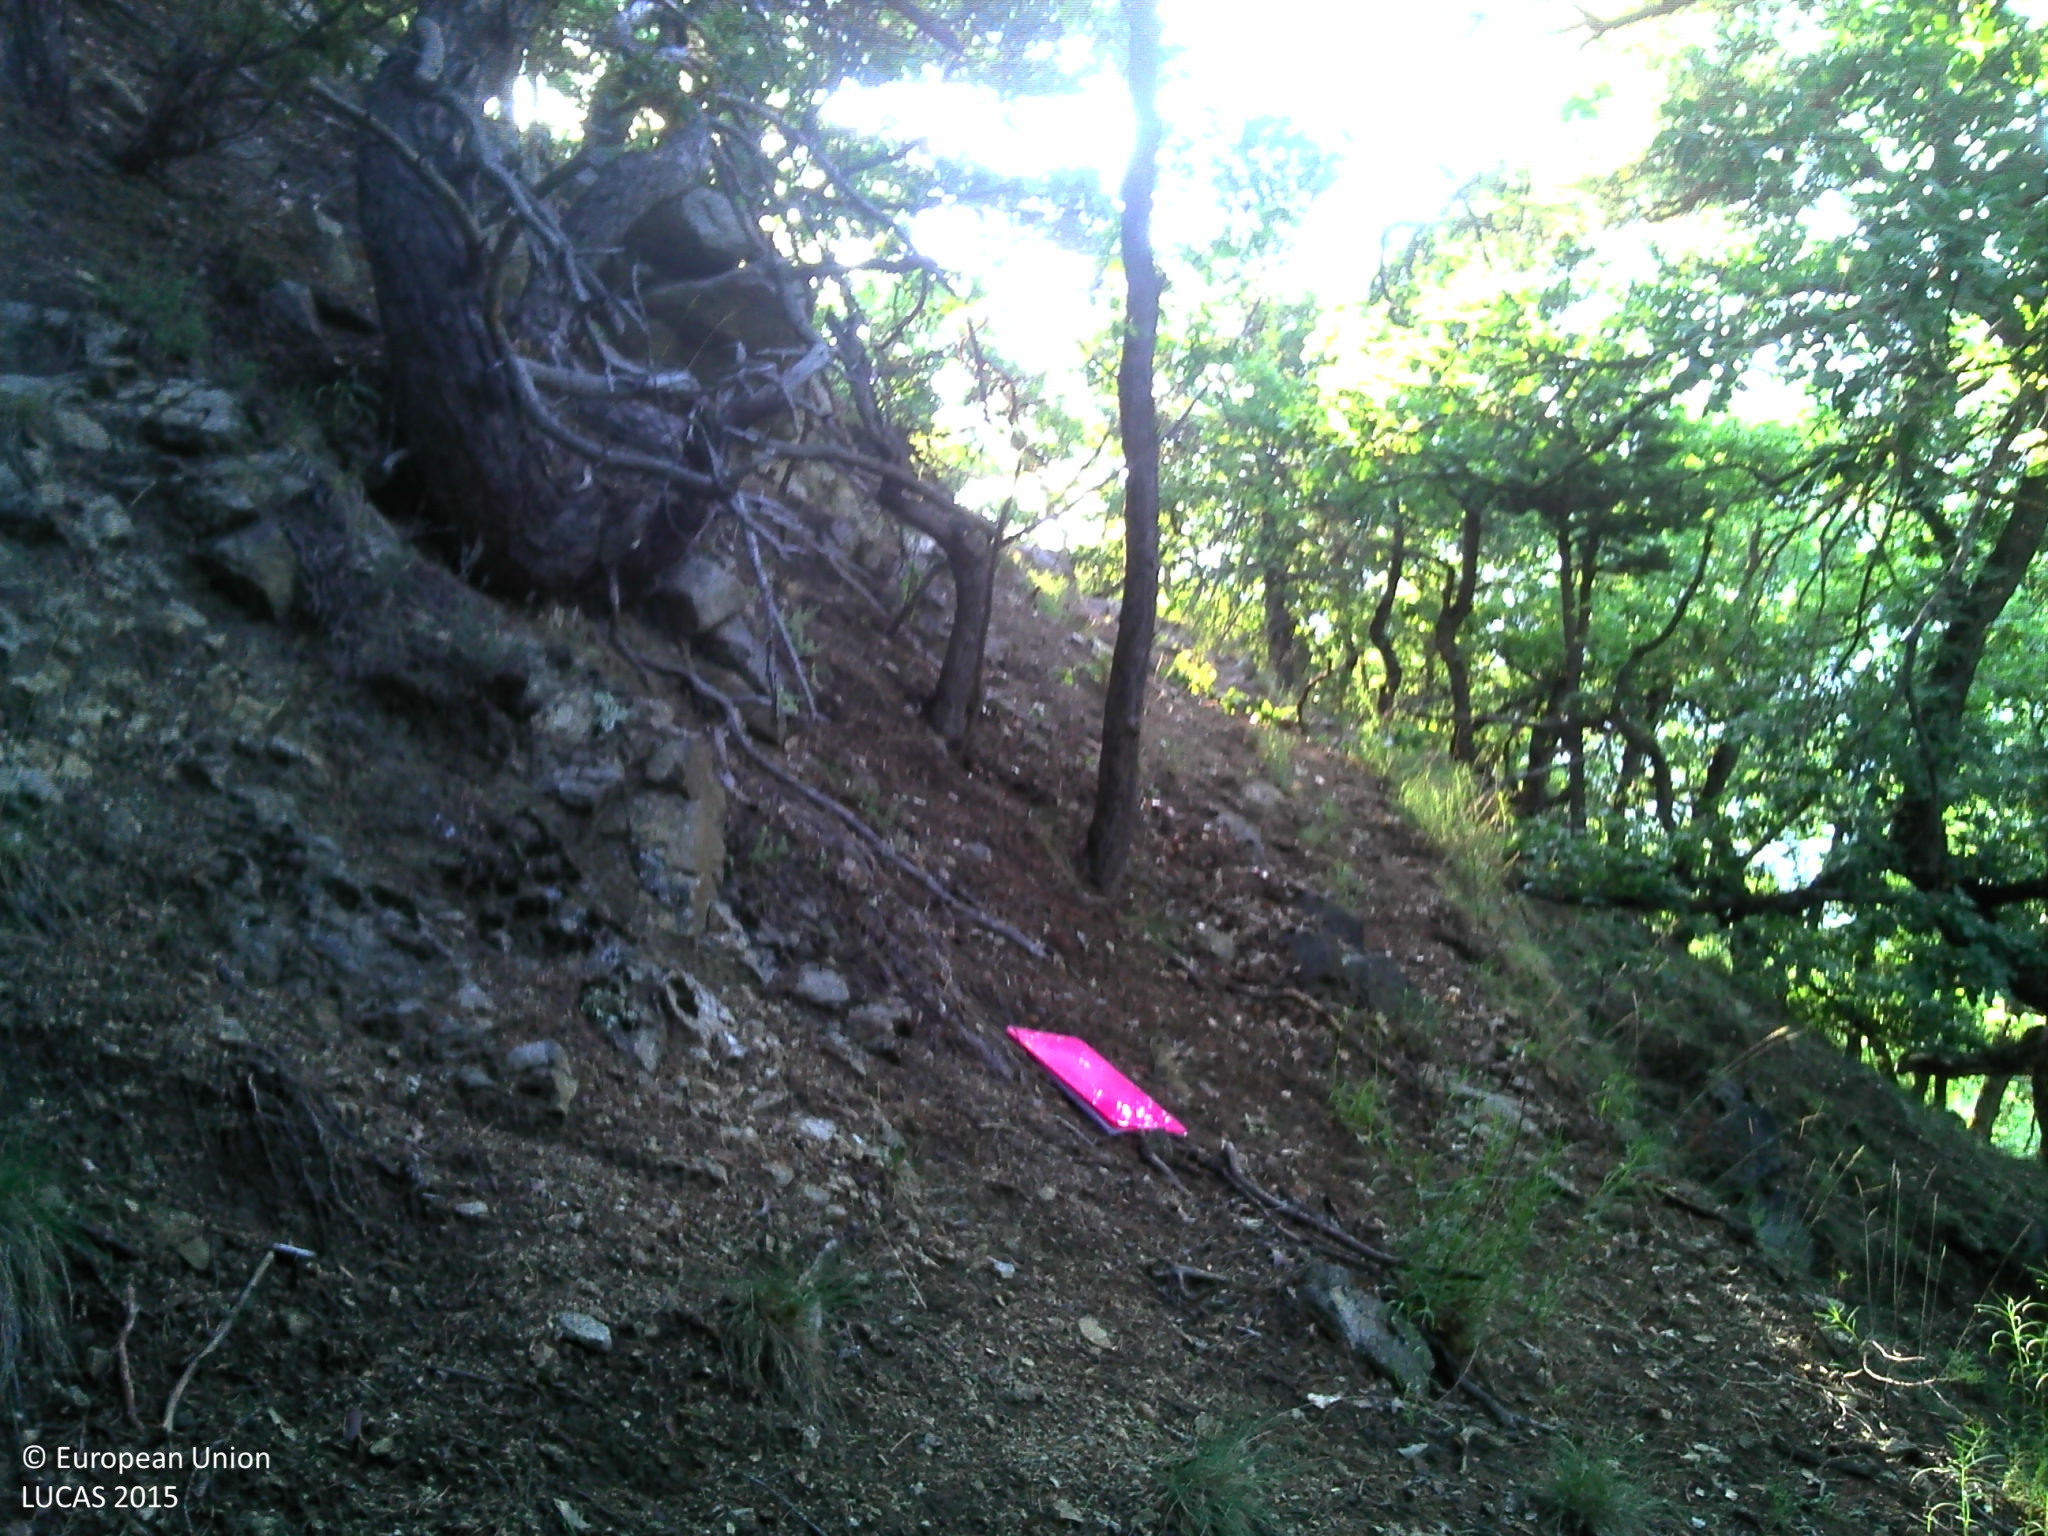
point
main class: Woodland
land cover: Pine dominated mixed woodland
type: mesophytic deciduous forest
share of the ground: > 75 %
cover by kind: broadleaved forest trees 55 %, coniferous forest trees 40 %, unconsolidated bare surface 5 %
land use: Semi-natural and natural areas not in use
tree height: > 5 m
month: July
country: FR
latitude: 42.5150
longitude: 2.1851
